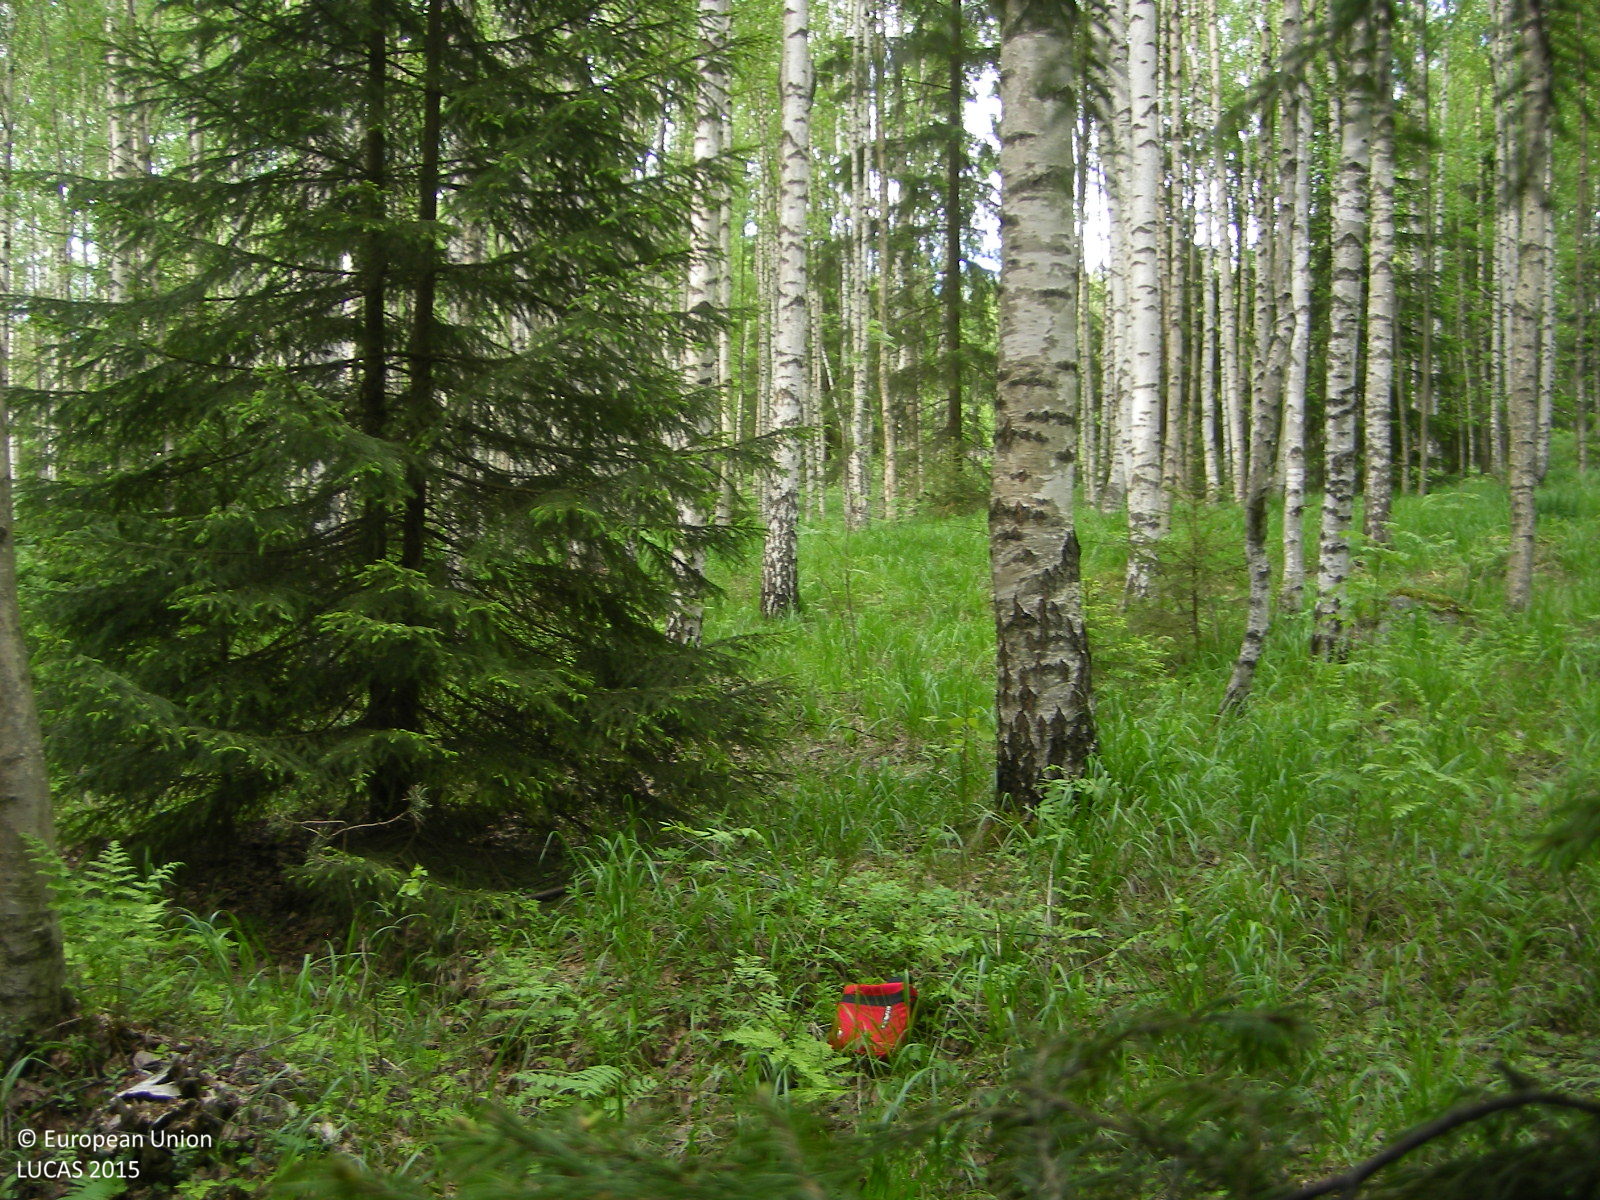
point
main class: Woodland
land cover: Broadleaved woodland
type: boreal forest
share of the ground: > 75 %
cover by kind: broadleaved forest trees 80 %, herbaceous plants 15 %, coniferous forest trees 5 %
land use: Forestry
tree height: > 5 m
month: June
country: FI
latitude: 60.3088
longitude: 24.8295
